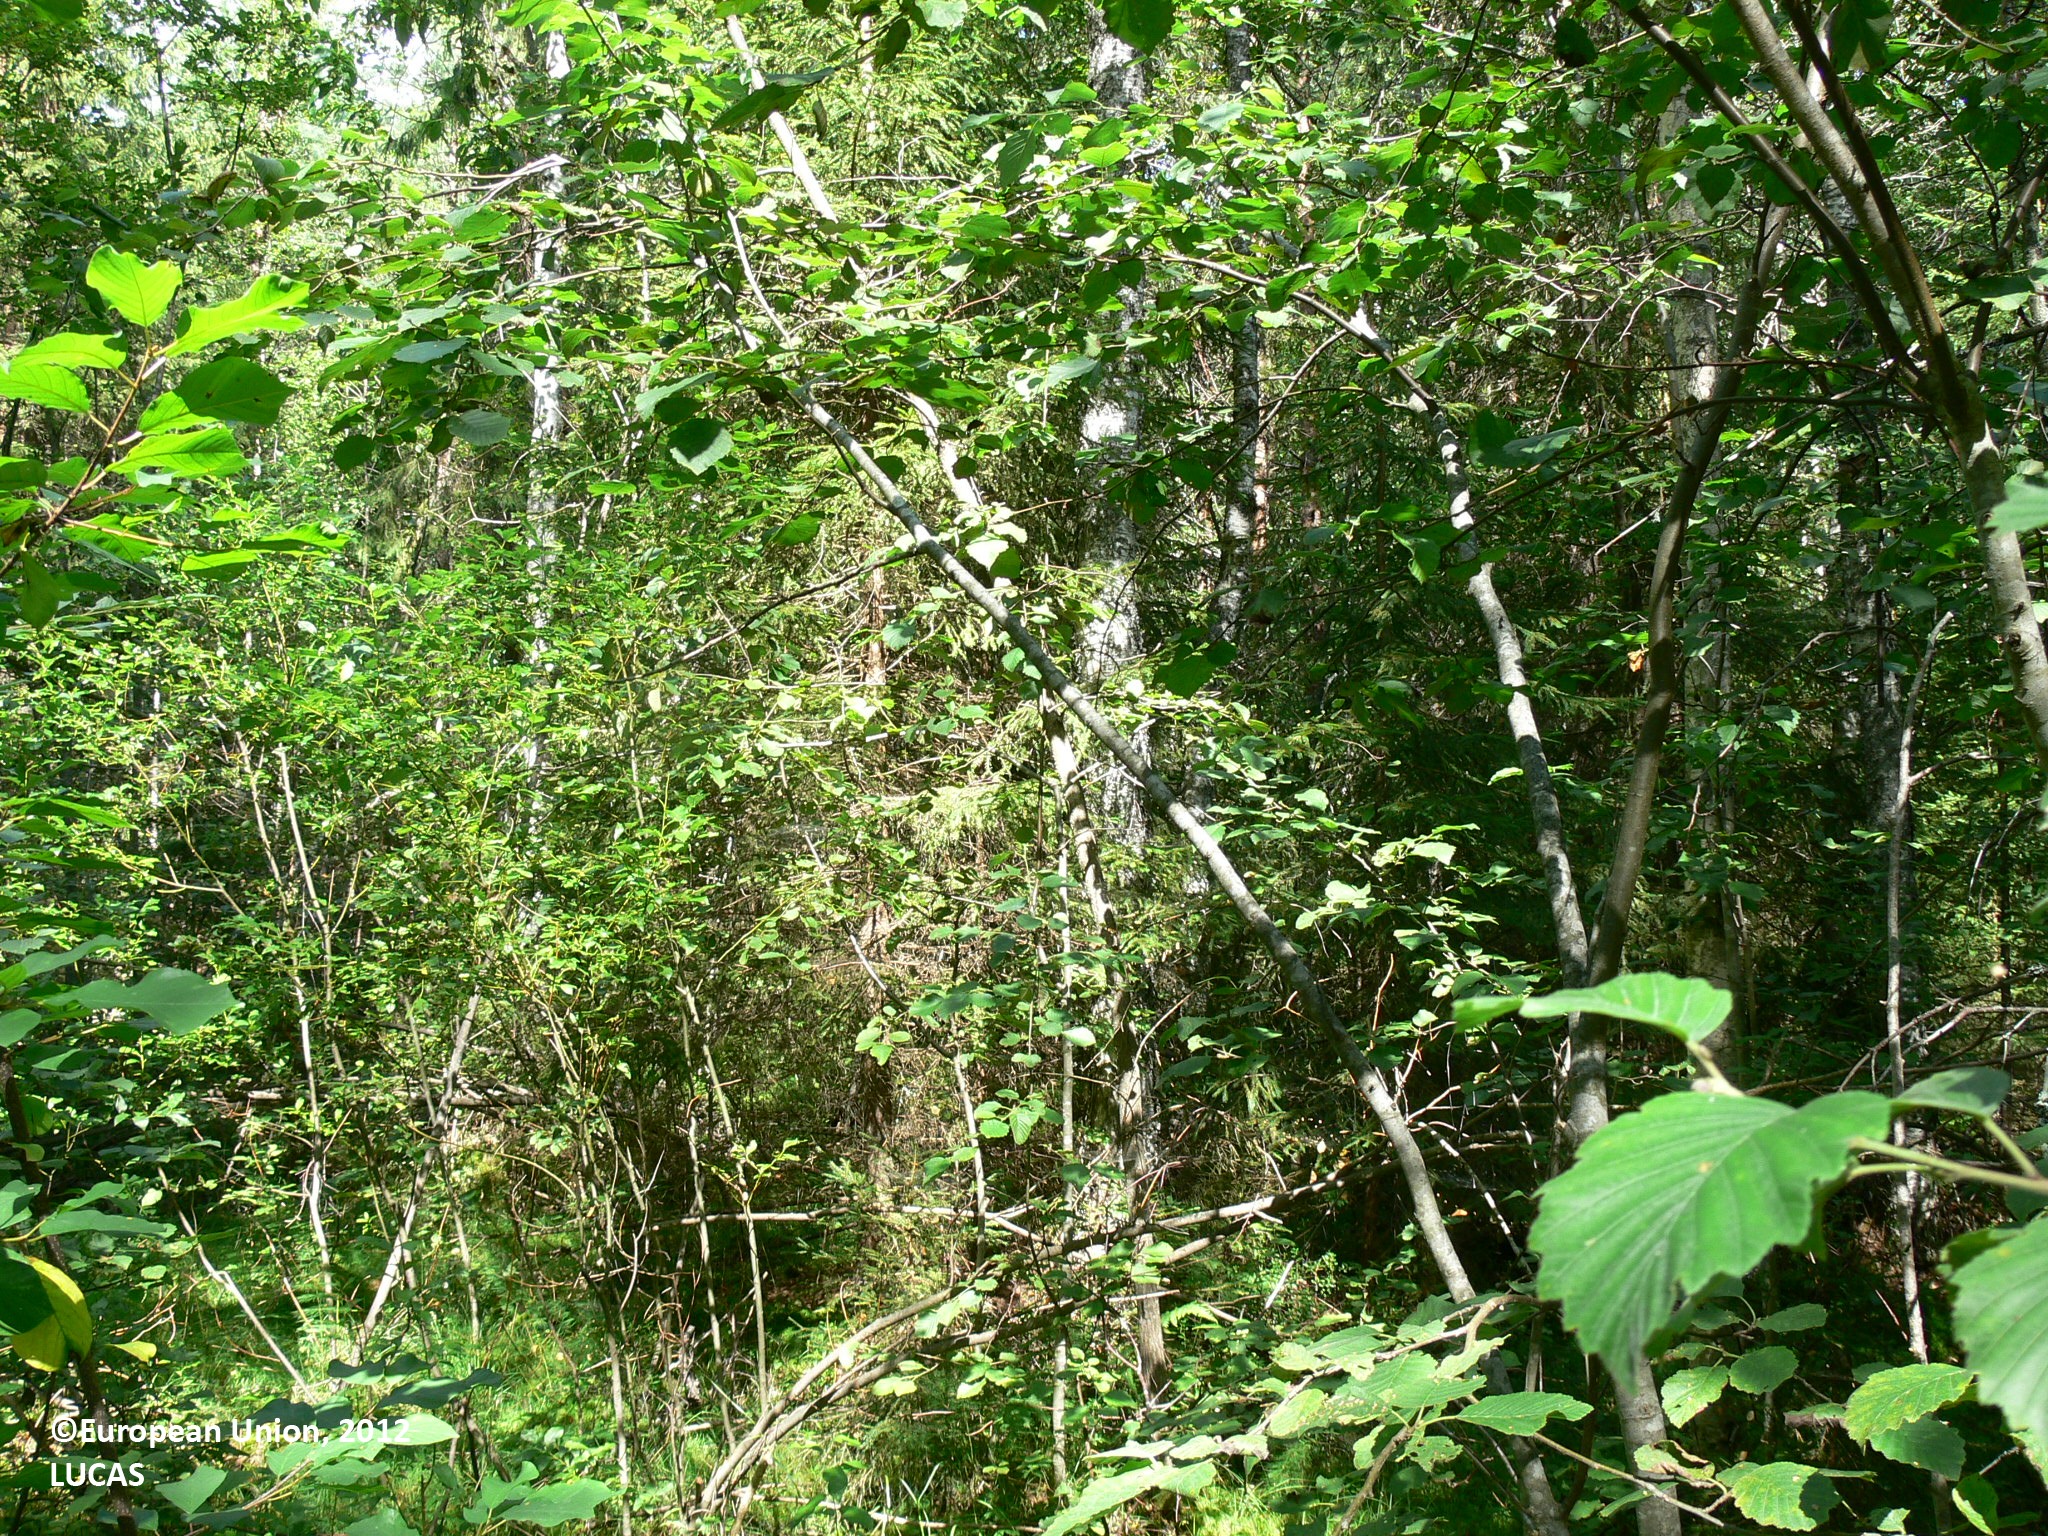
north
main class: Woodland
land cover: Other mixed woodland
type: boreal forest
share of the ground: > 75 %
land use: Forestry
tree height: > 5 m
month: August
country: FI
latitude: 62.1325
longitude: 30.3590
